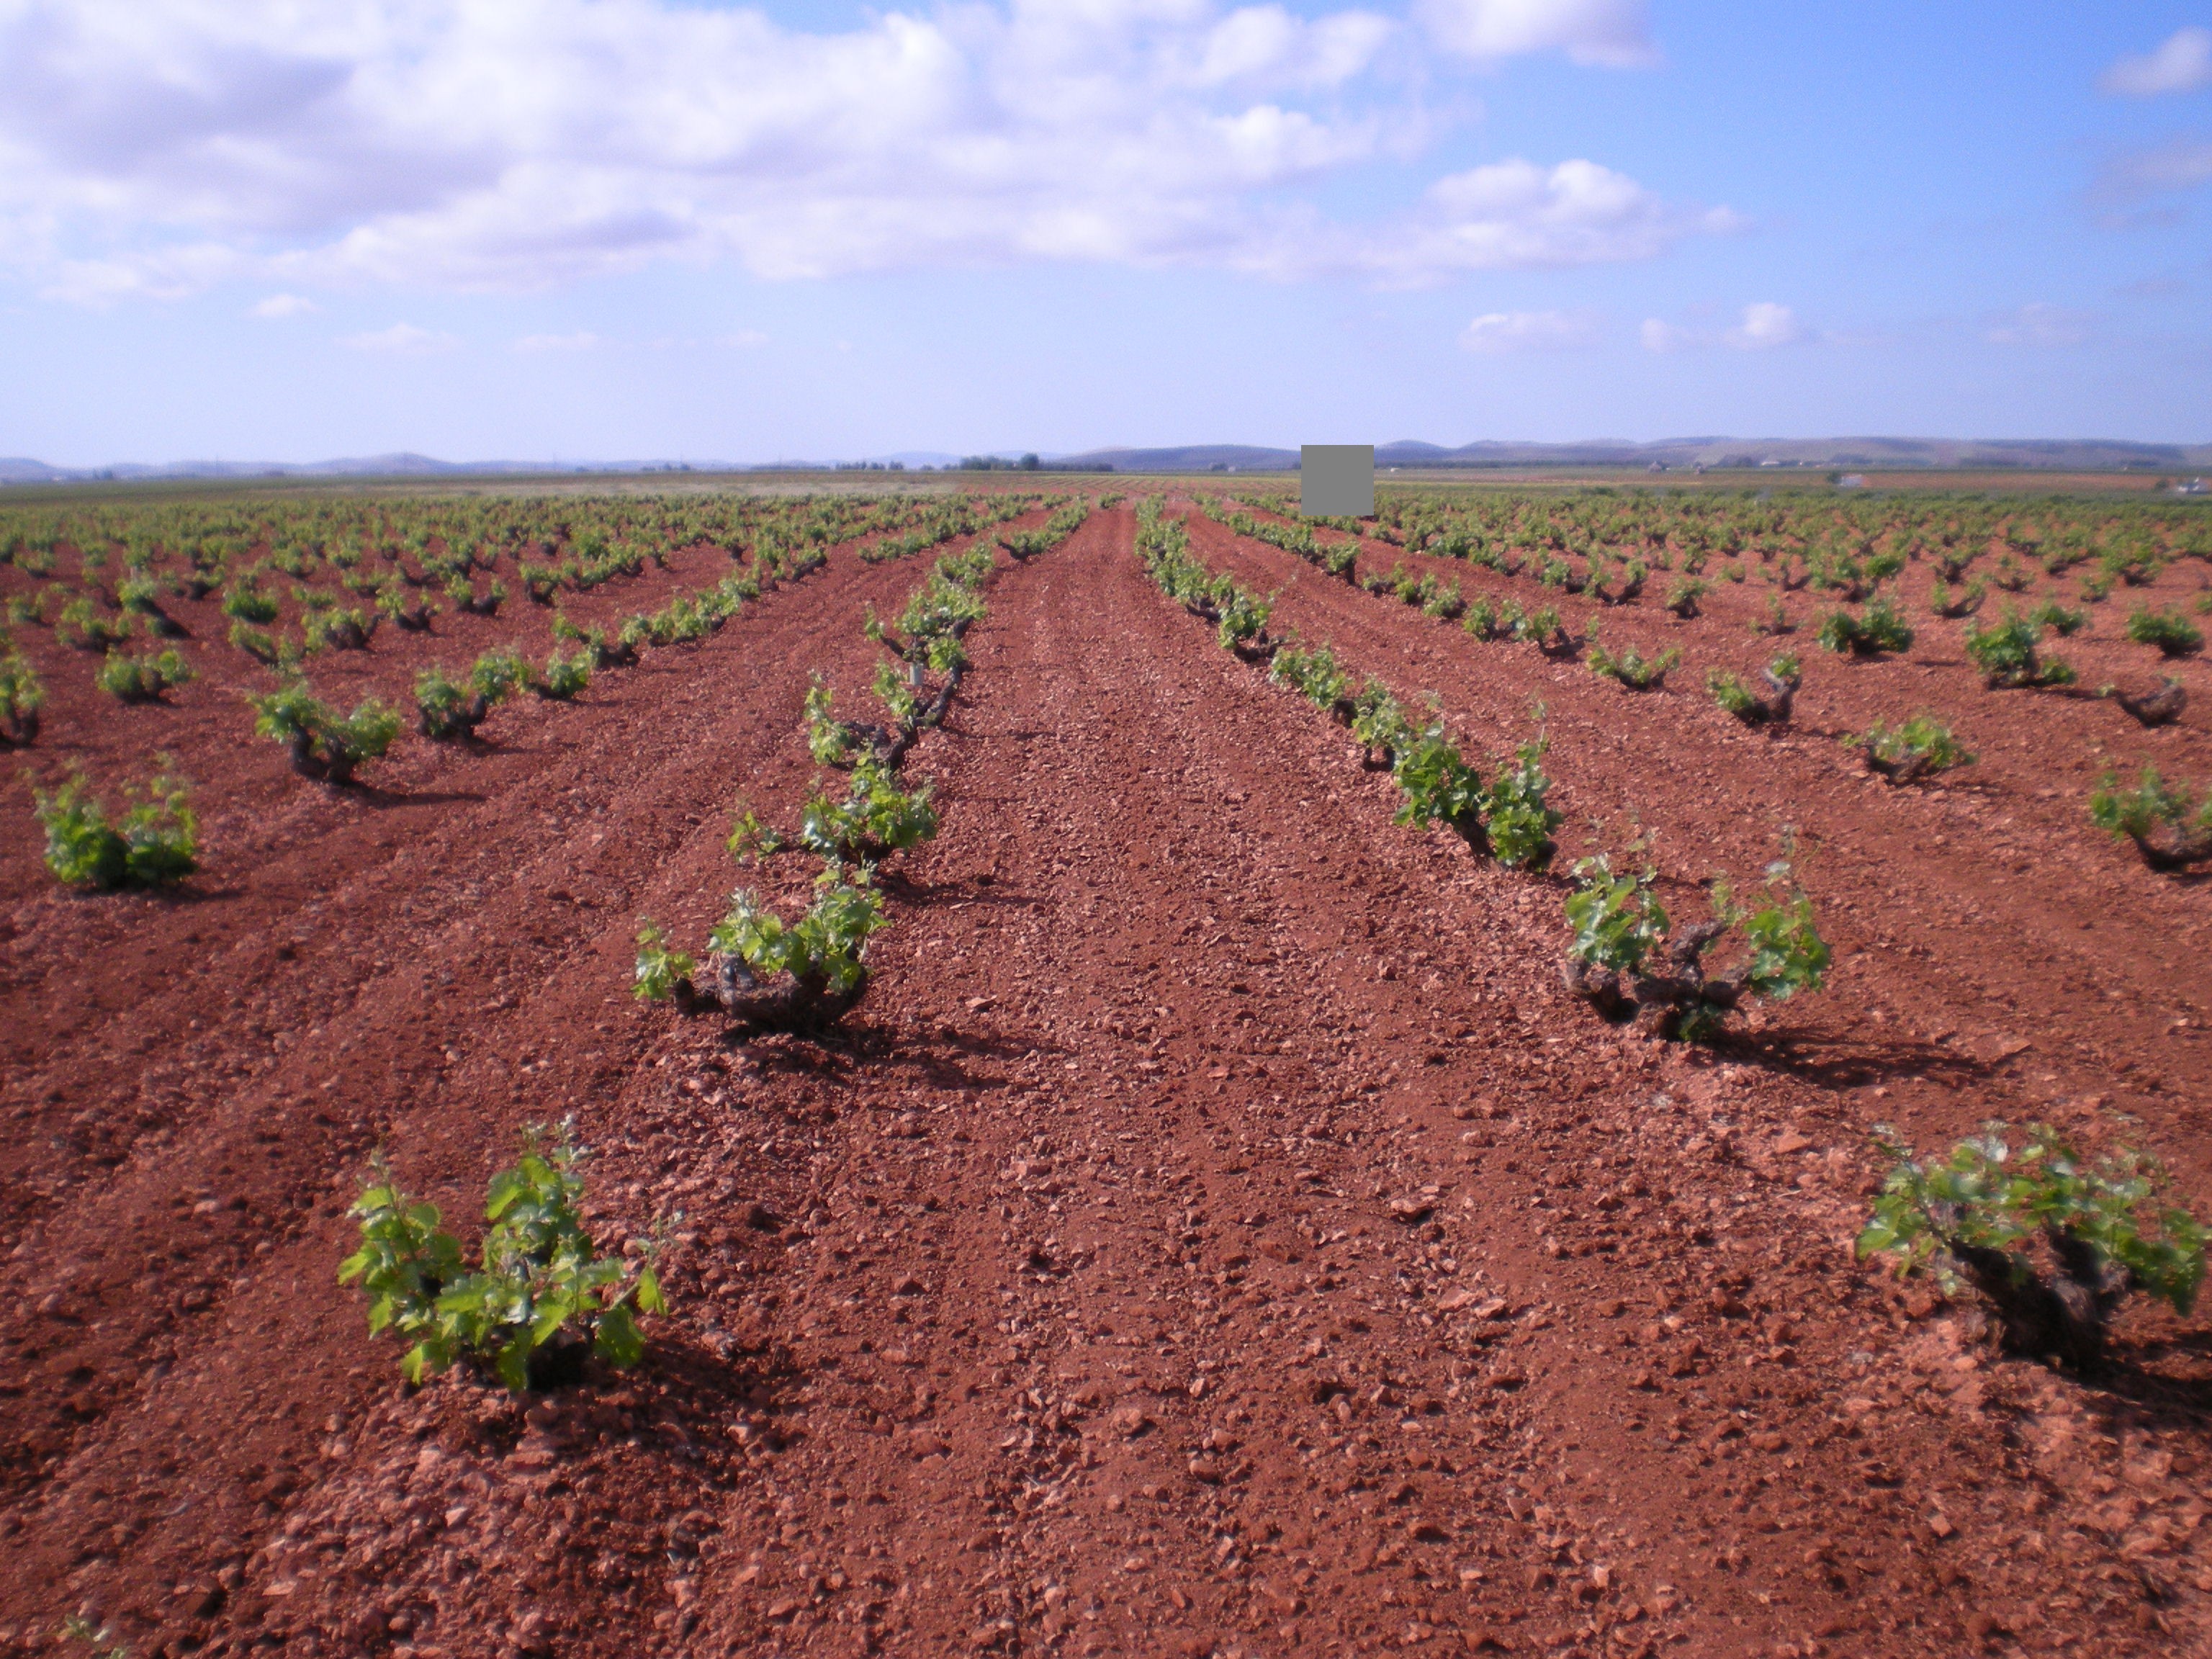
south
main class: Cropland
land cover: Vineyards
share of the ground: 10 - 25 %
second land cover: Other bare soil
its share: > 75 %
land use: Agriculture (excluding fallow land and kitchen gardens)
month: May
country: ES
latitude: 38.8083
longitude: -3.4279
